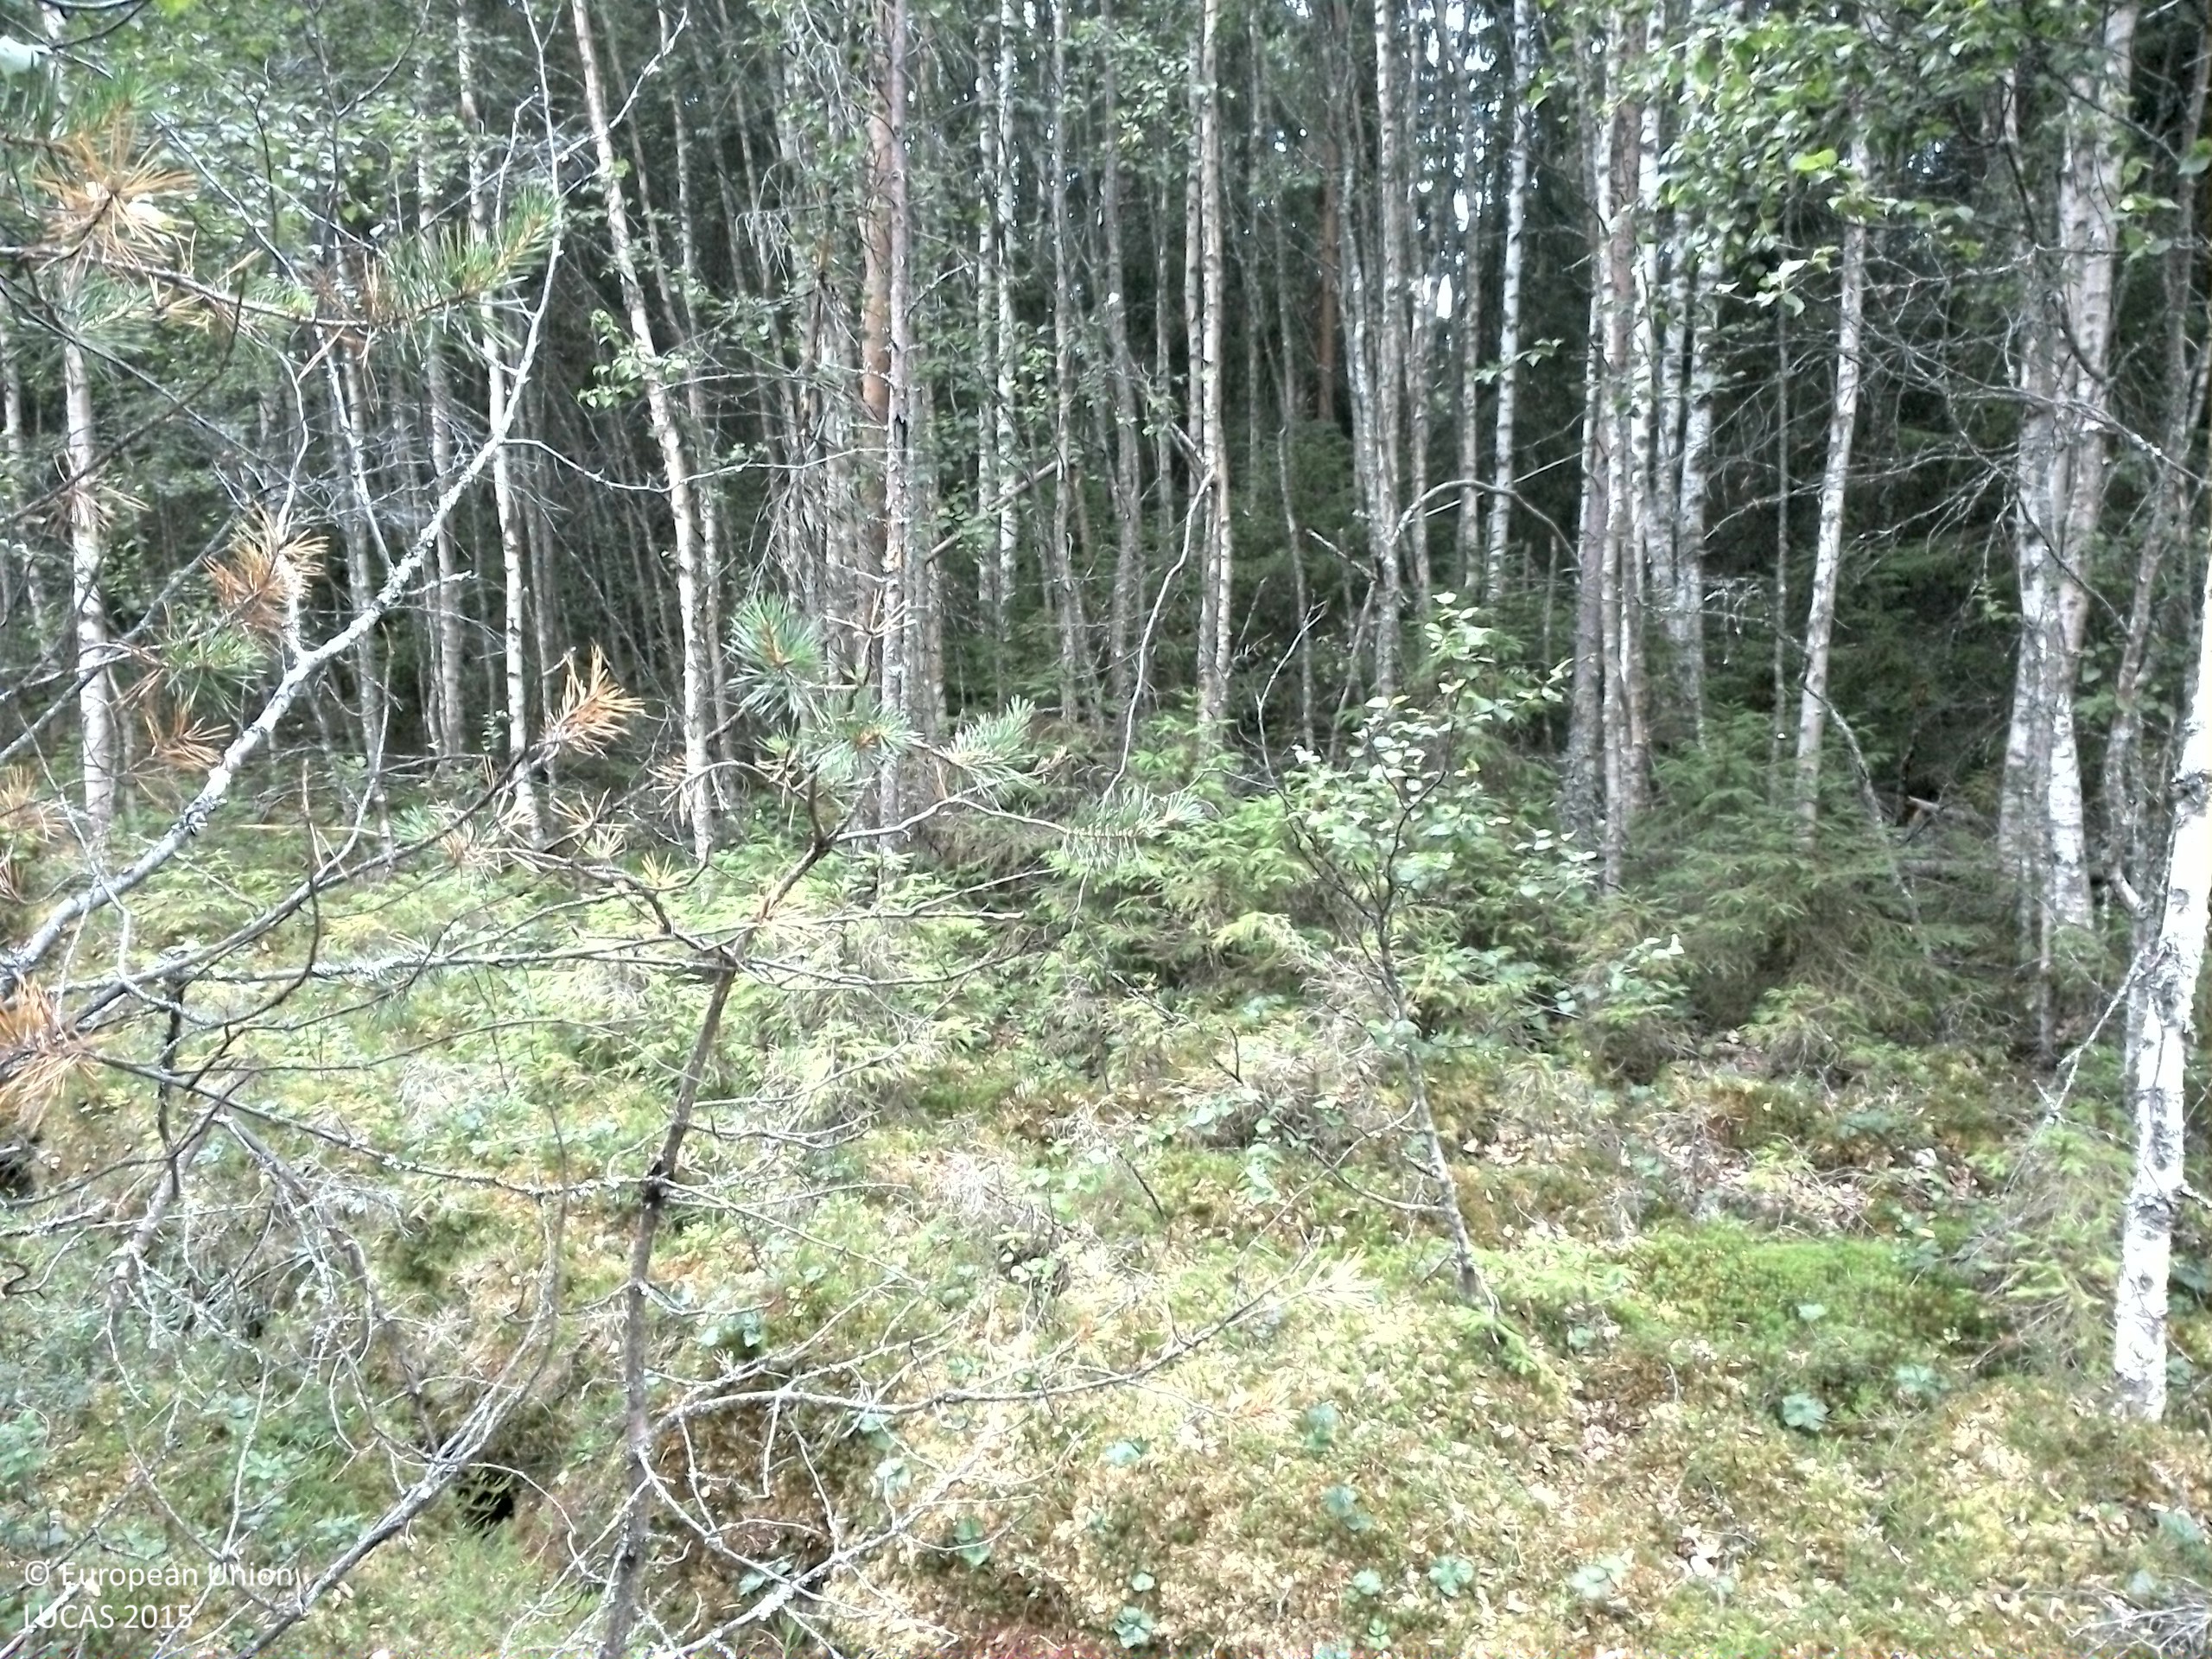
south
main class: Woodland
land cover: Pine dominated mixed woodland
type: boreal forest
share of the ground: 50 - 75 %
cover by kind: coniferous forest trees 35 %, shrubs 25 %, broadleaved forest trees 20 %, lichens and mosses 15 %, herbaceous plants 5 %
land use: Forestry
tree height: > 5 m
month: August
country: SE
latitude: 63.5919
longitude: 16.5631
